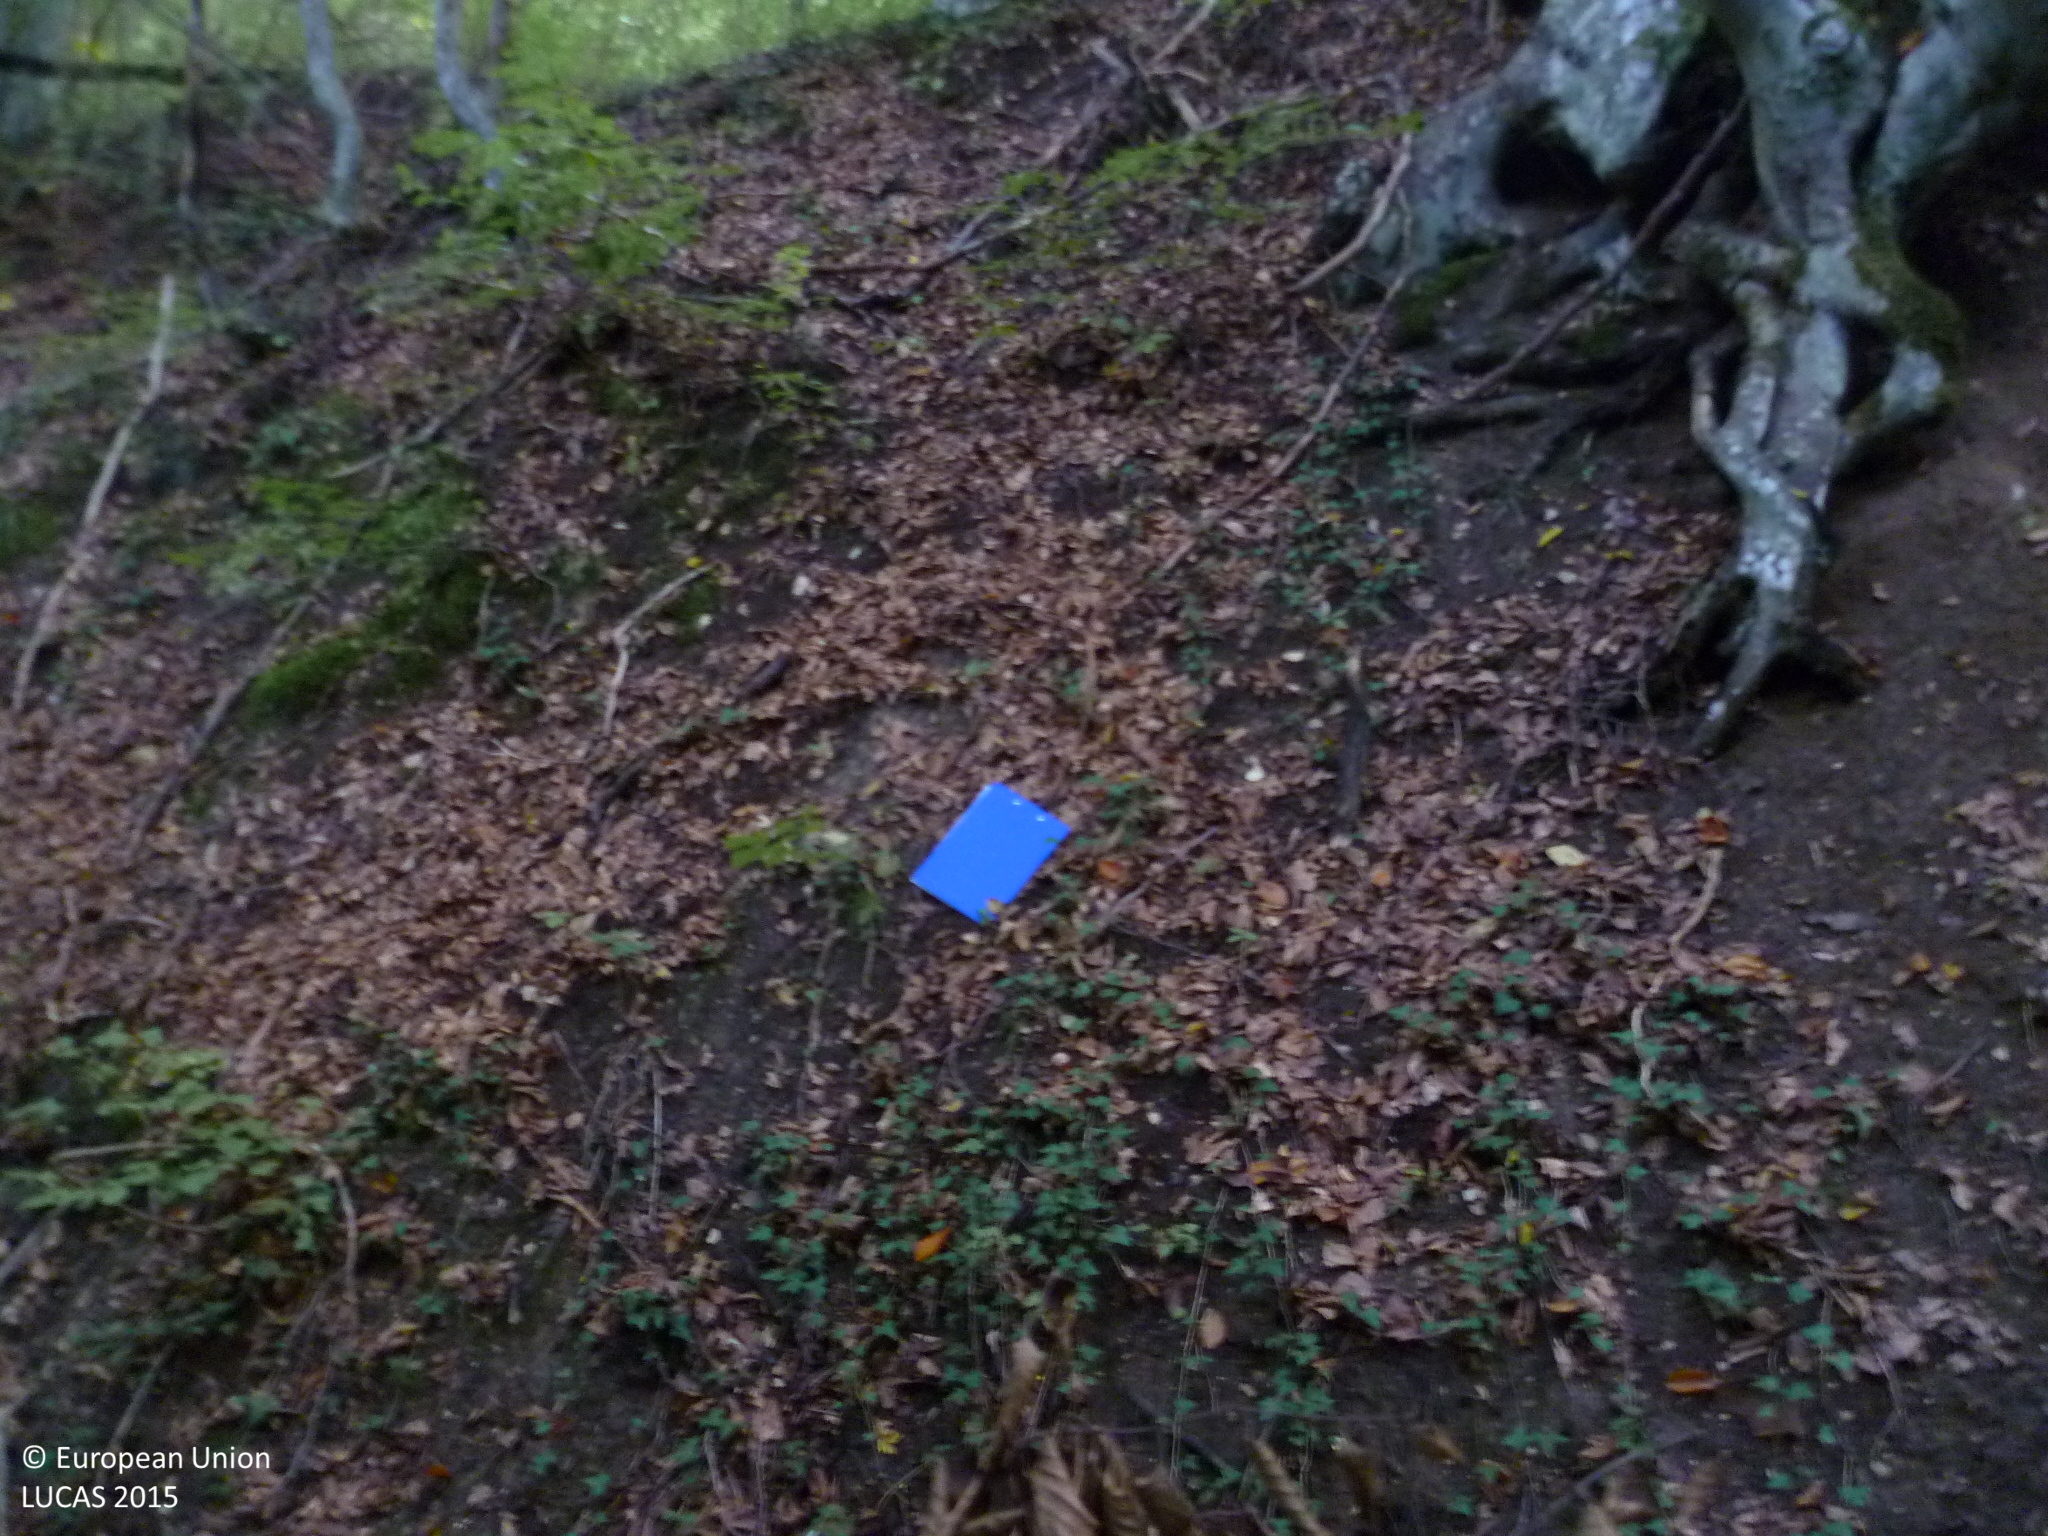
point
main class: Woodland
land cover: Broadleaved woodland
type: beech forest
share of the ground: 50 - 75 %
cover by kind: broadleaved forest trees 70 %, unconsolidated bare surface 20 %, lichens and mosses 10 %
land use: Forestry
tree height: > 5 m
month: October
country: BG
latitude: 42.8559
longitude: 22.6937
